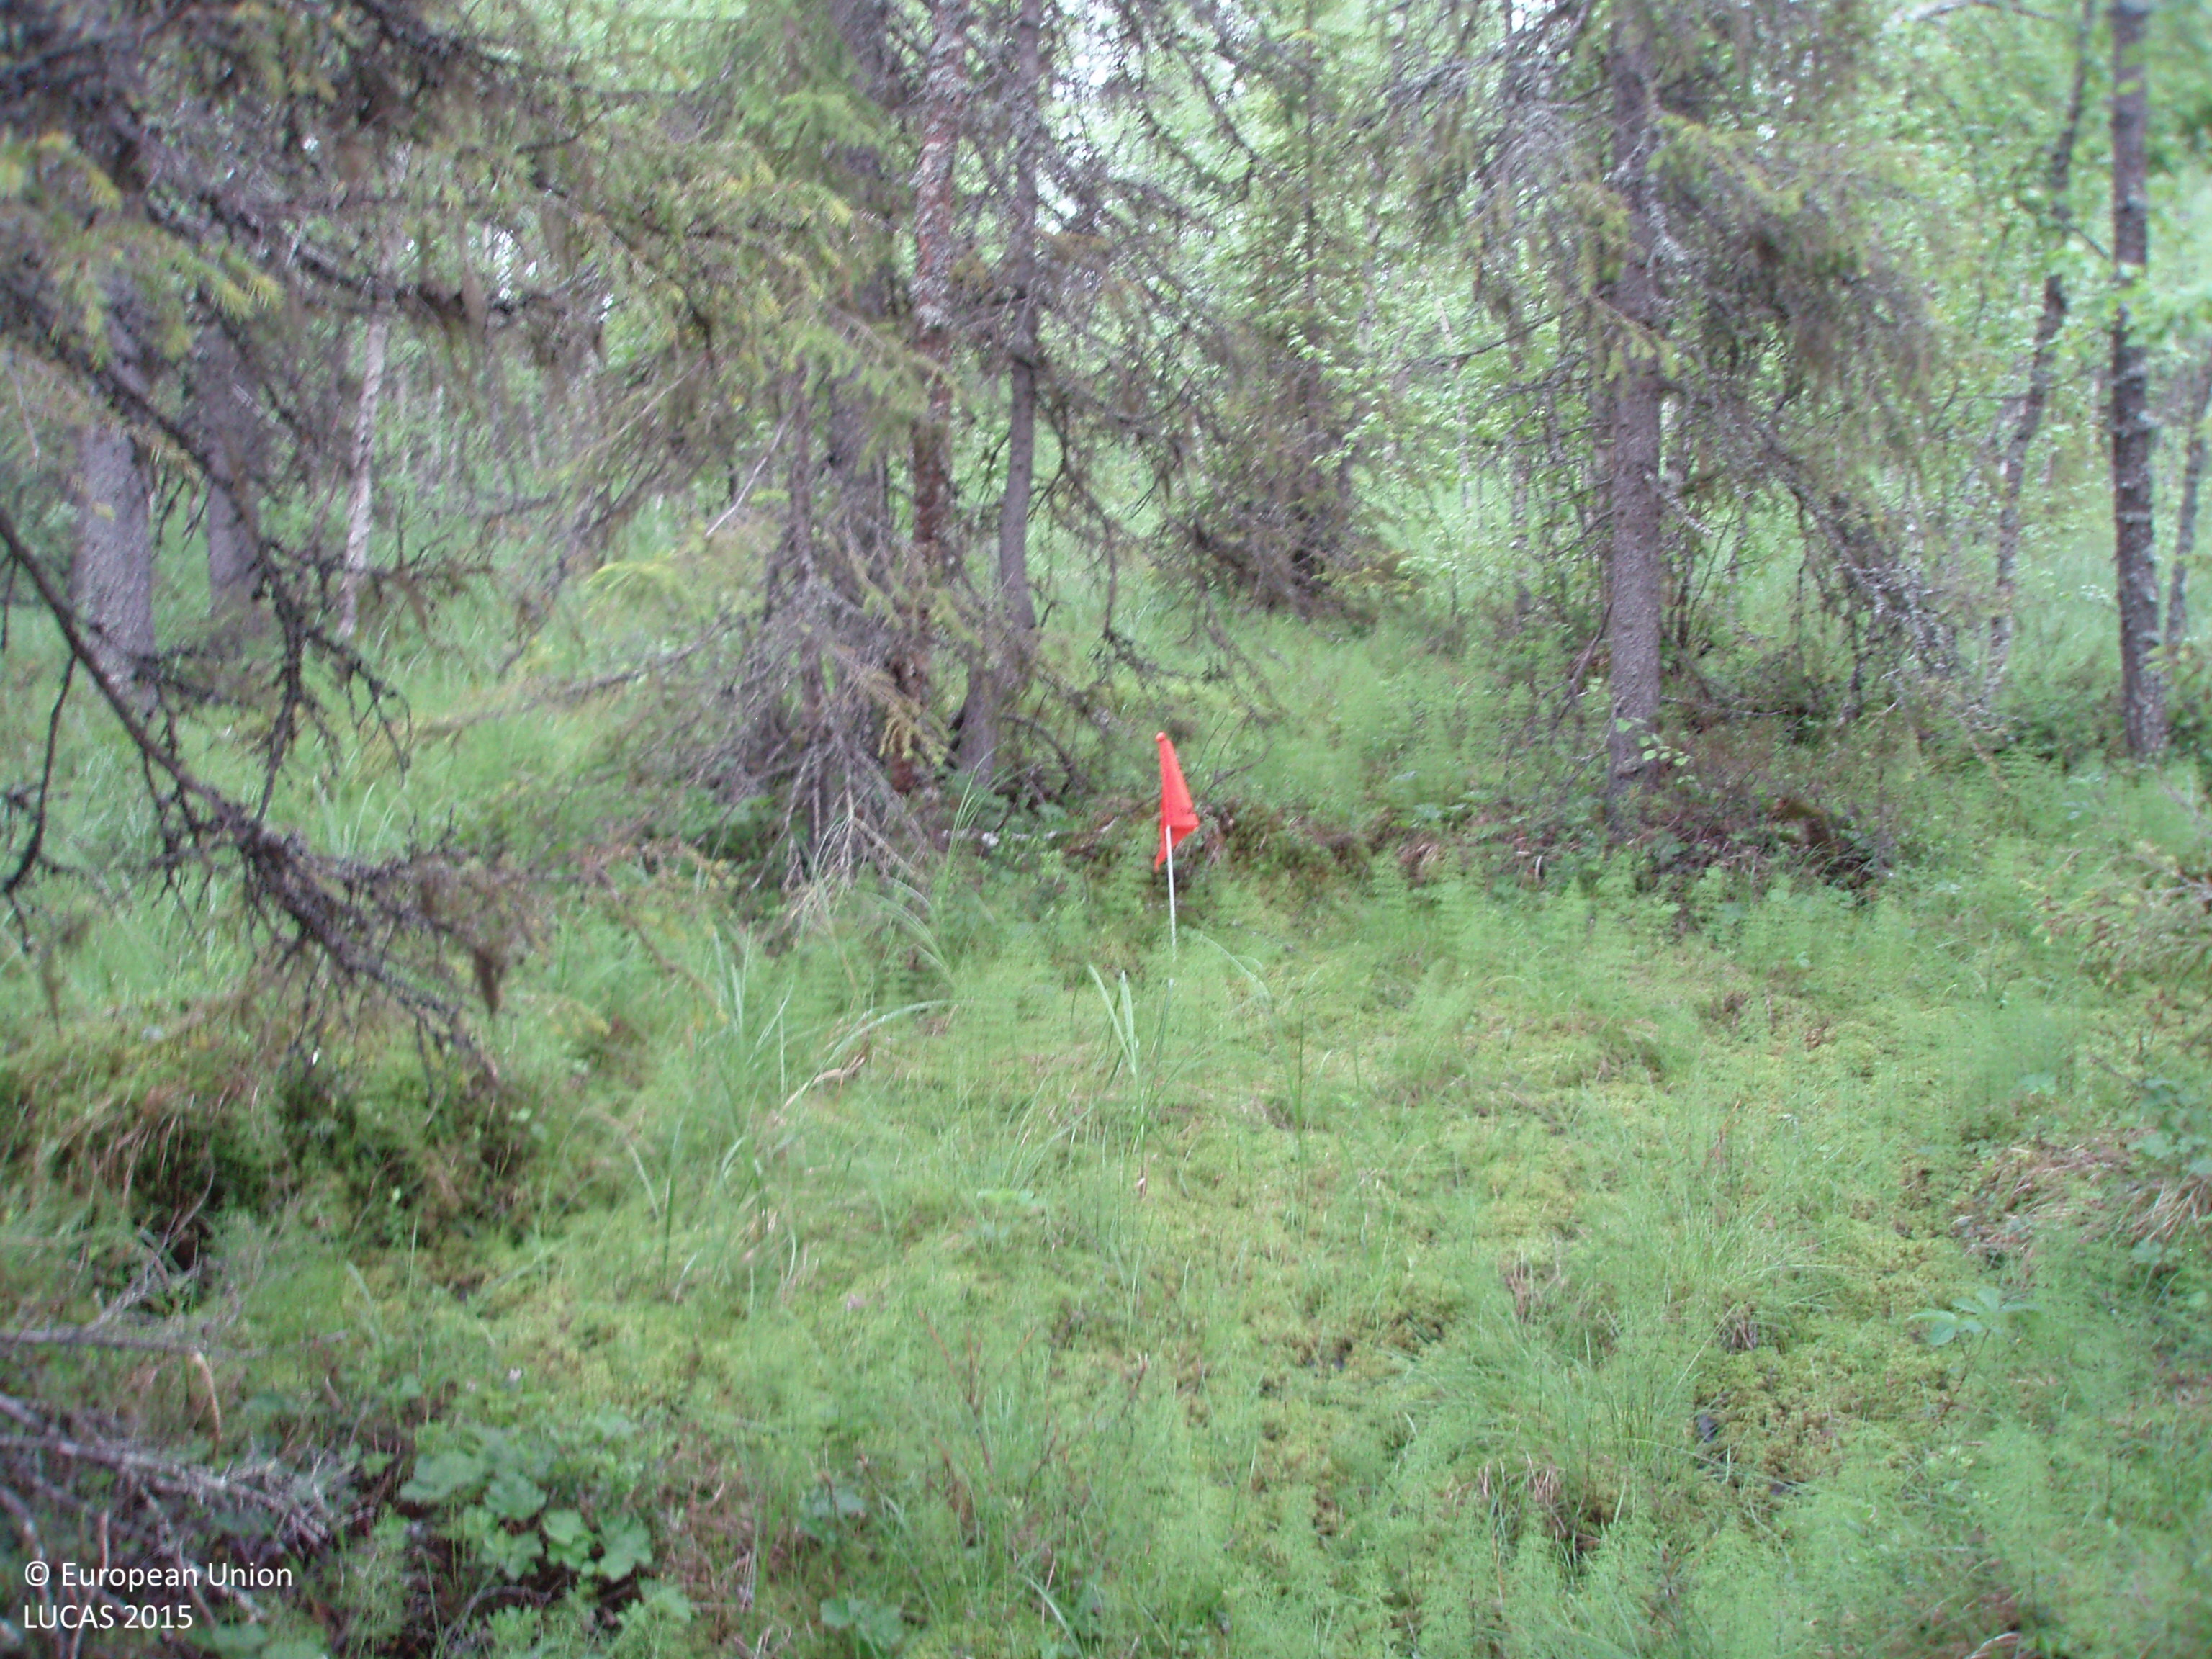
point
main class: Woodland
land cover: Spruce dominated mixed woodland
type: boreal forest
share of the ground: 50 - 75 %
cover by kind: coniferous forest trees 40 %, broadleaved forest trees 20 %, shrubs 20 %, herbaceous plants 20 %
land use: Forestry
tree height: > 5 m
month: July
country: FI
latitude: 67.2714
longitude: 28.2381
